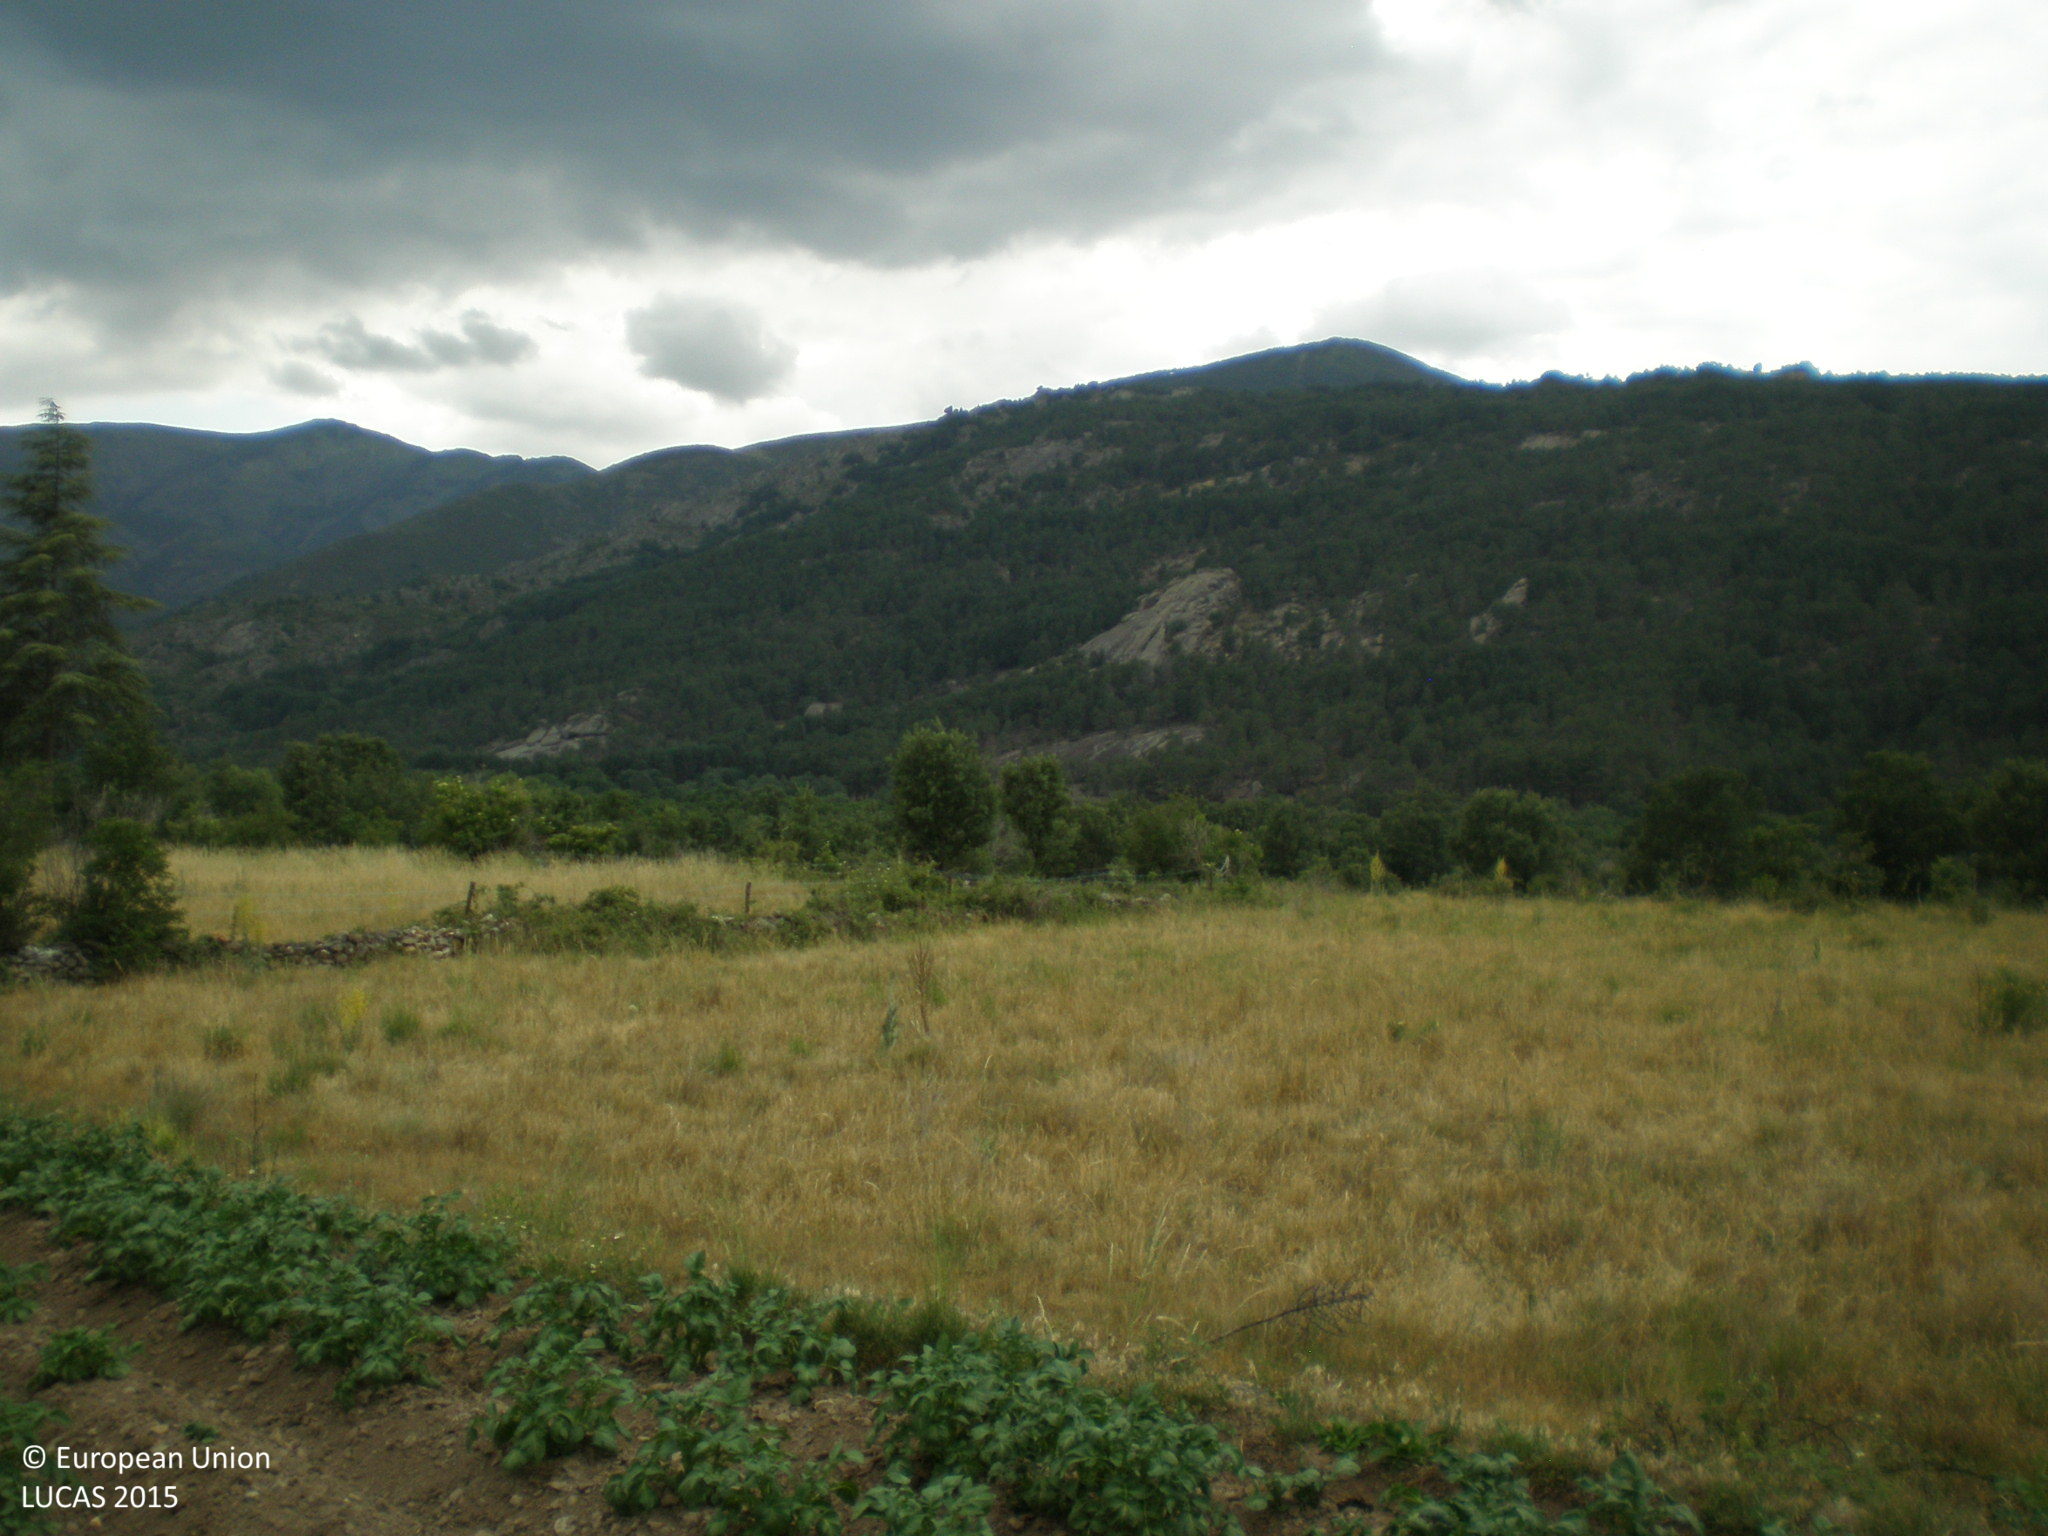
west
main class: Cropland
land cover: Potatoes
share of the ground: < 10 %
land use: Agriculture (excluding fallow land and kitchen gardens)
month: June
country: ES
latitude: 40.2760
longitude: -5.5060
